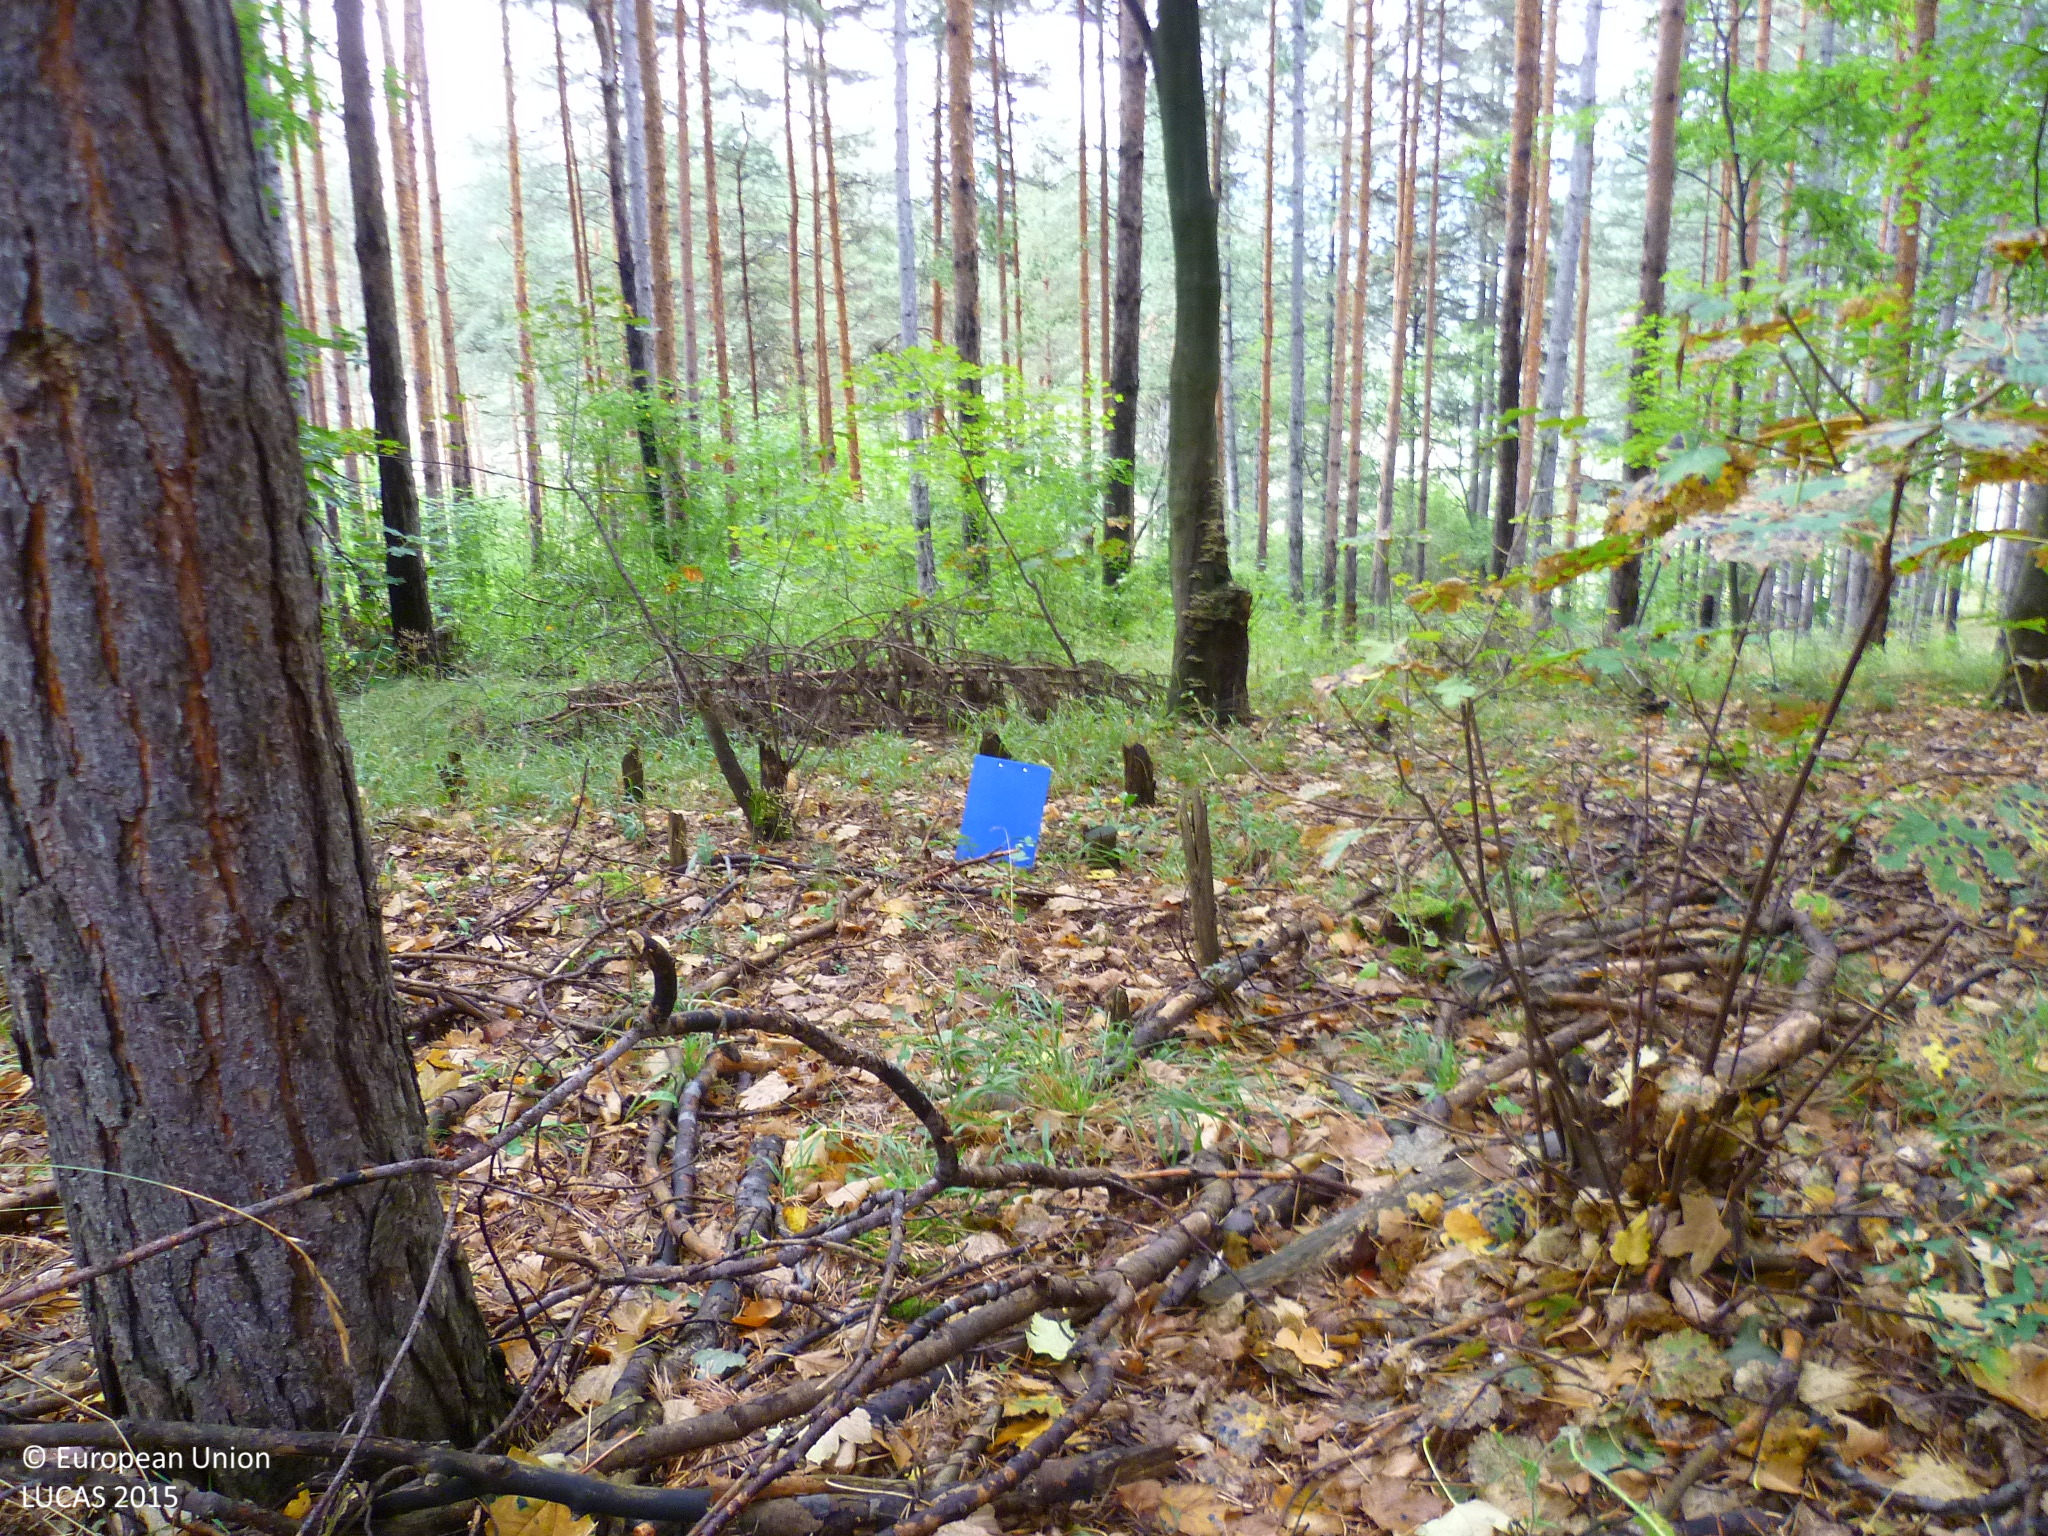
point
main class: Woodland
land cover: Pine dominated mixed woodland
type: alpine coniferous forest
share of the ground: 50 - 75 %
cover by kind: coniferous forest trees 50 %, broadleaved forest trees 30 %, unconsolidated bare surface 10 %, shrubs 5 %, herbaceous plants 5 %
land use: Forestry
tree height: > 5 m
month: September
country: BG
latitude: 42.7573
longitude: 22.8953
